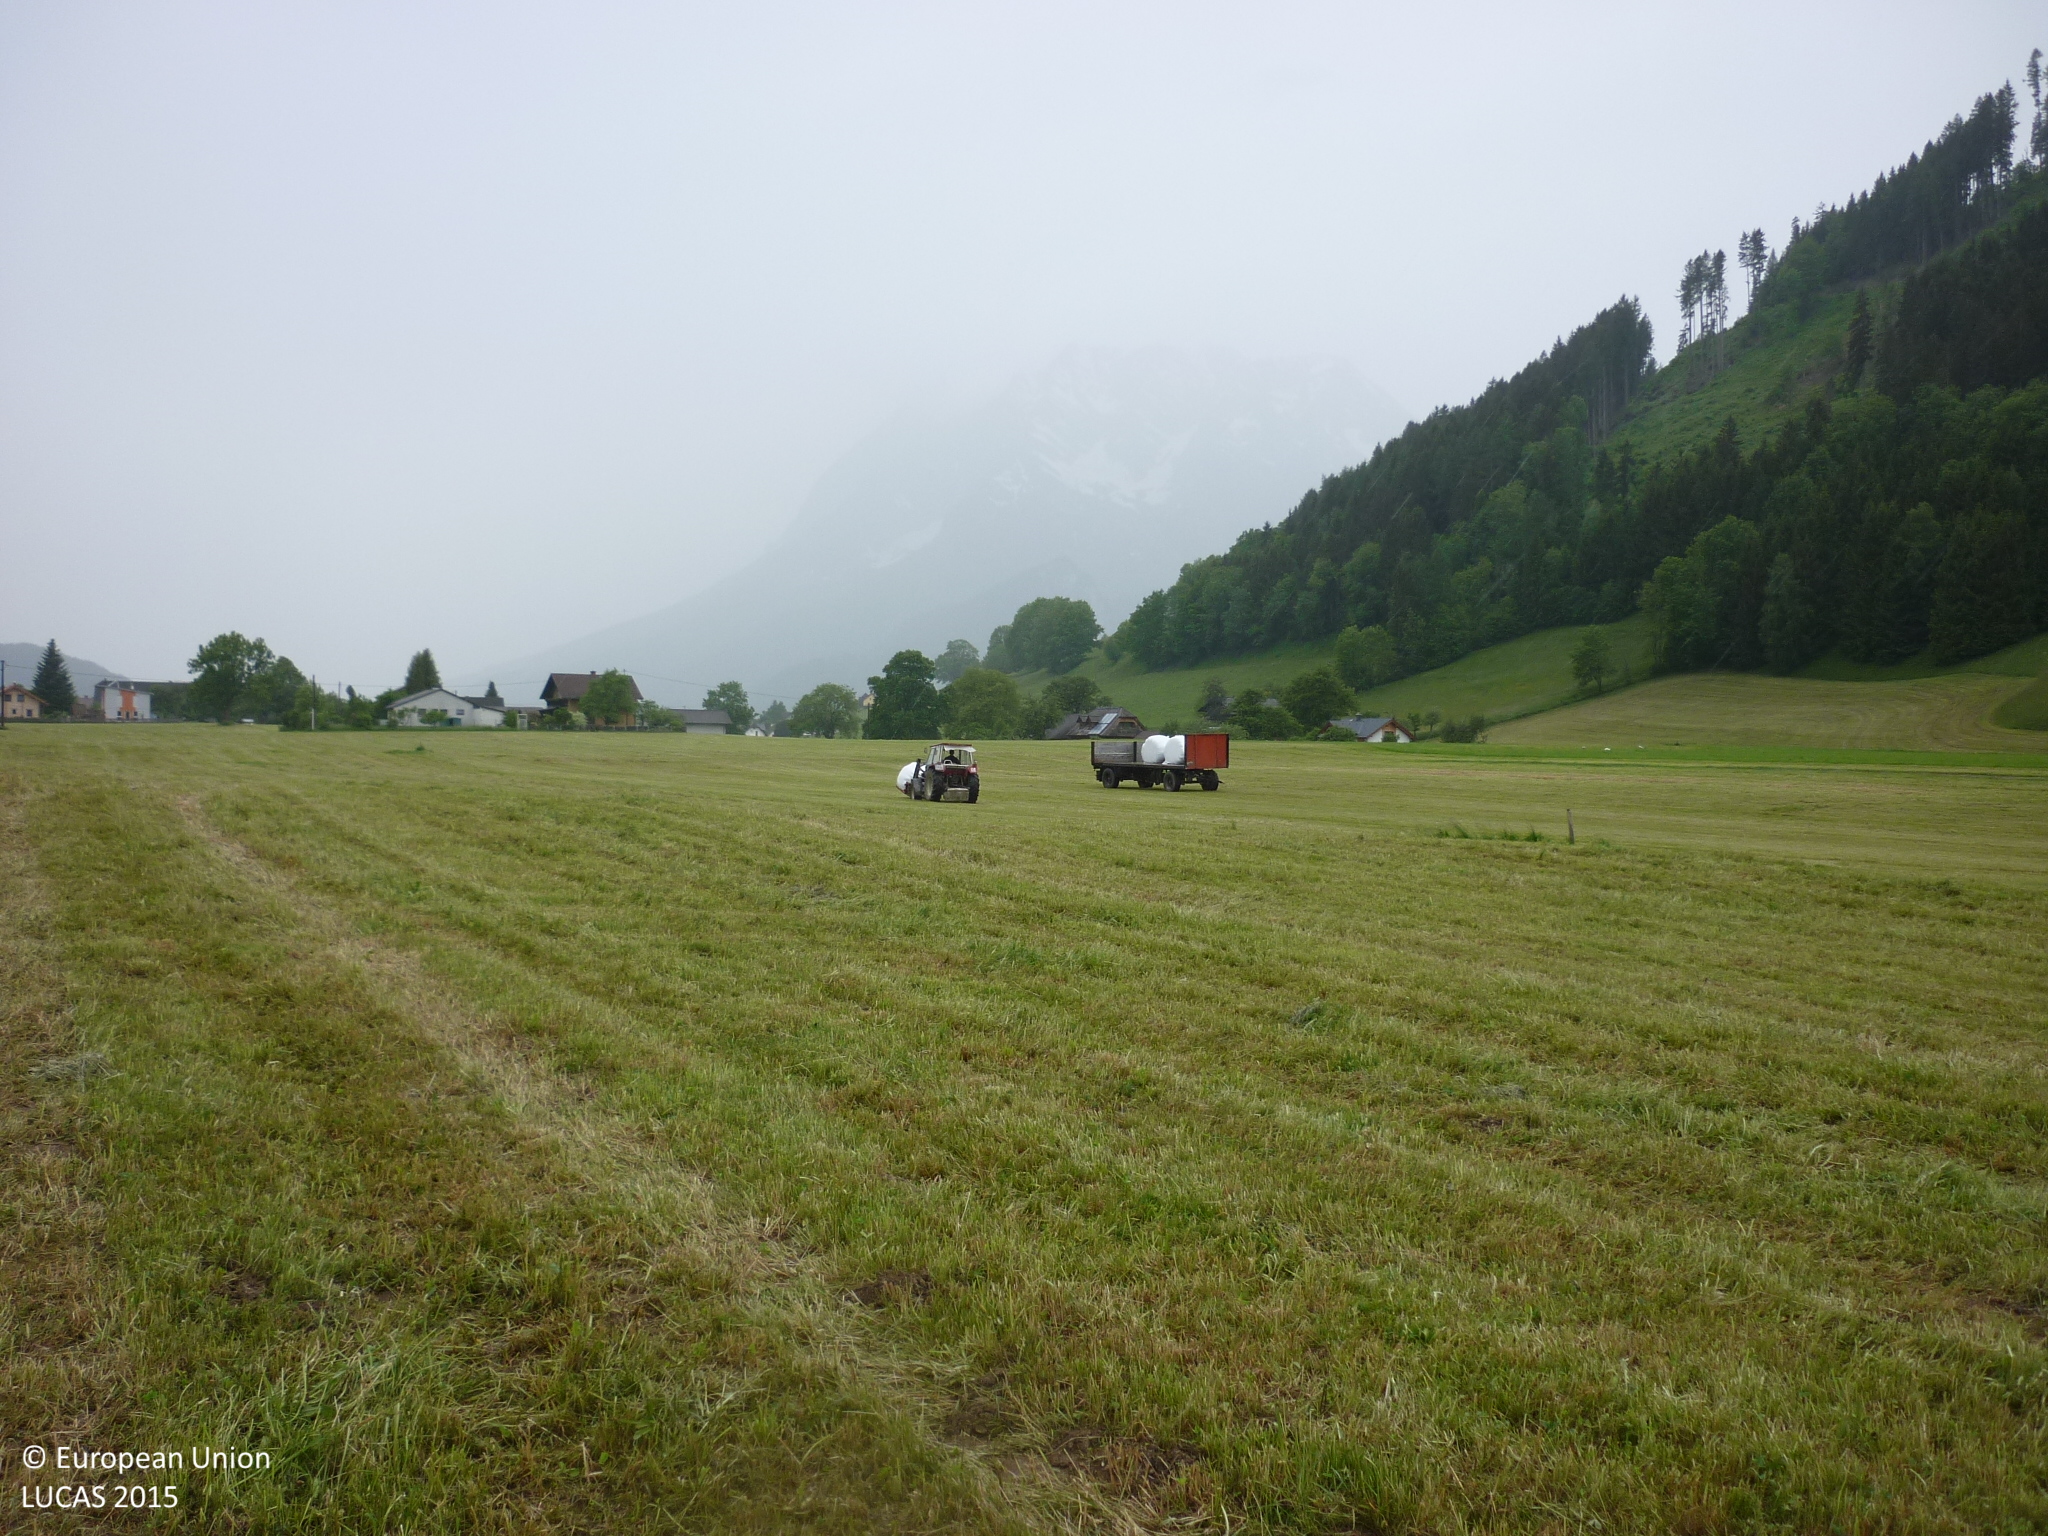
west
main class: Grassland
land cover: Grassland without tree/shrub cover
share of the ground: > 75 %
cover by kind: herbaceous plants 100 %
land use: Agriculture (excluding fallow land and kitchen gardens)
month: May
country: AT
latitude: 47.5155
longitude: 14.1286
